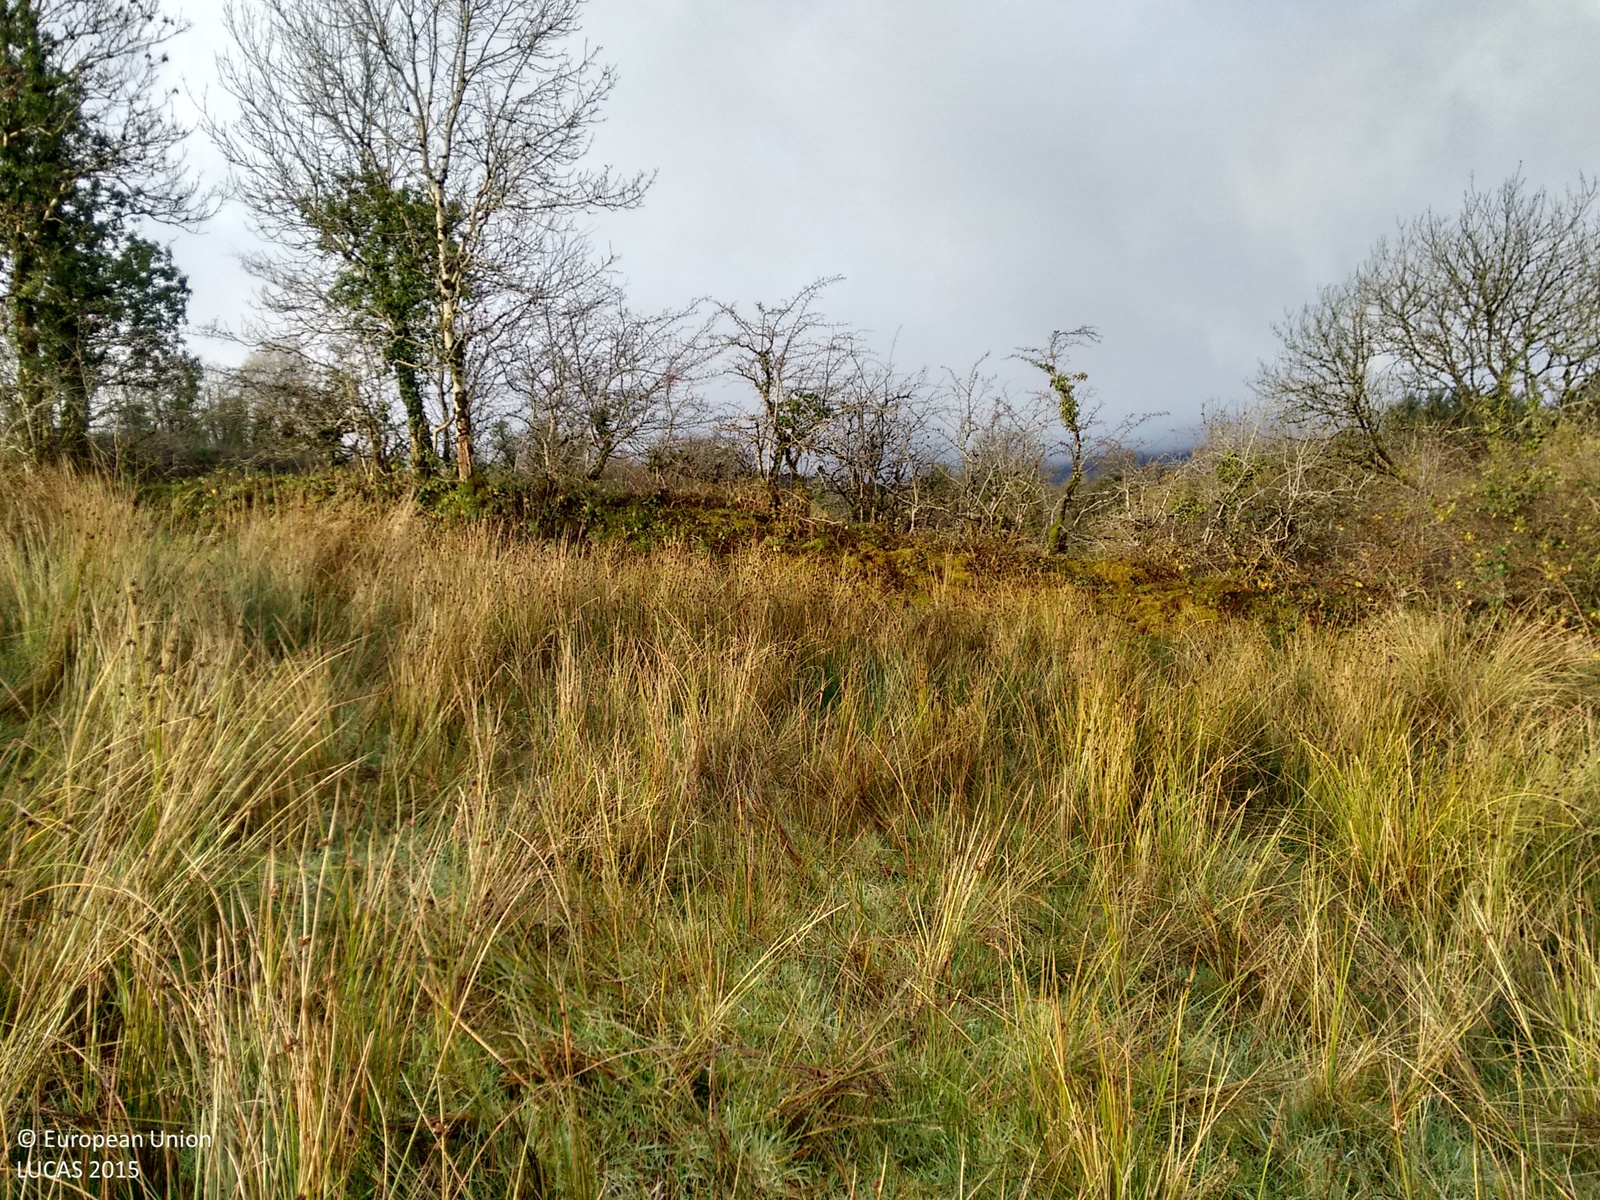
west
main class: Grassland
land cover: Grassland without tree/shrub cover
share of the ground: > 75 %
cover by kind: herbaceous plants 100 %
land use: Agriculture (excluding fallow land and kitchen gardens)
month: November
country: IE
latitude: 54.0663
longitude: -7.8793
